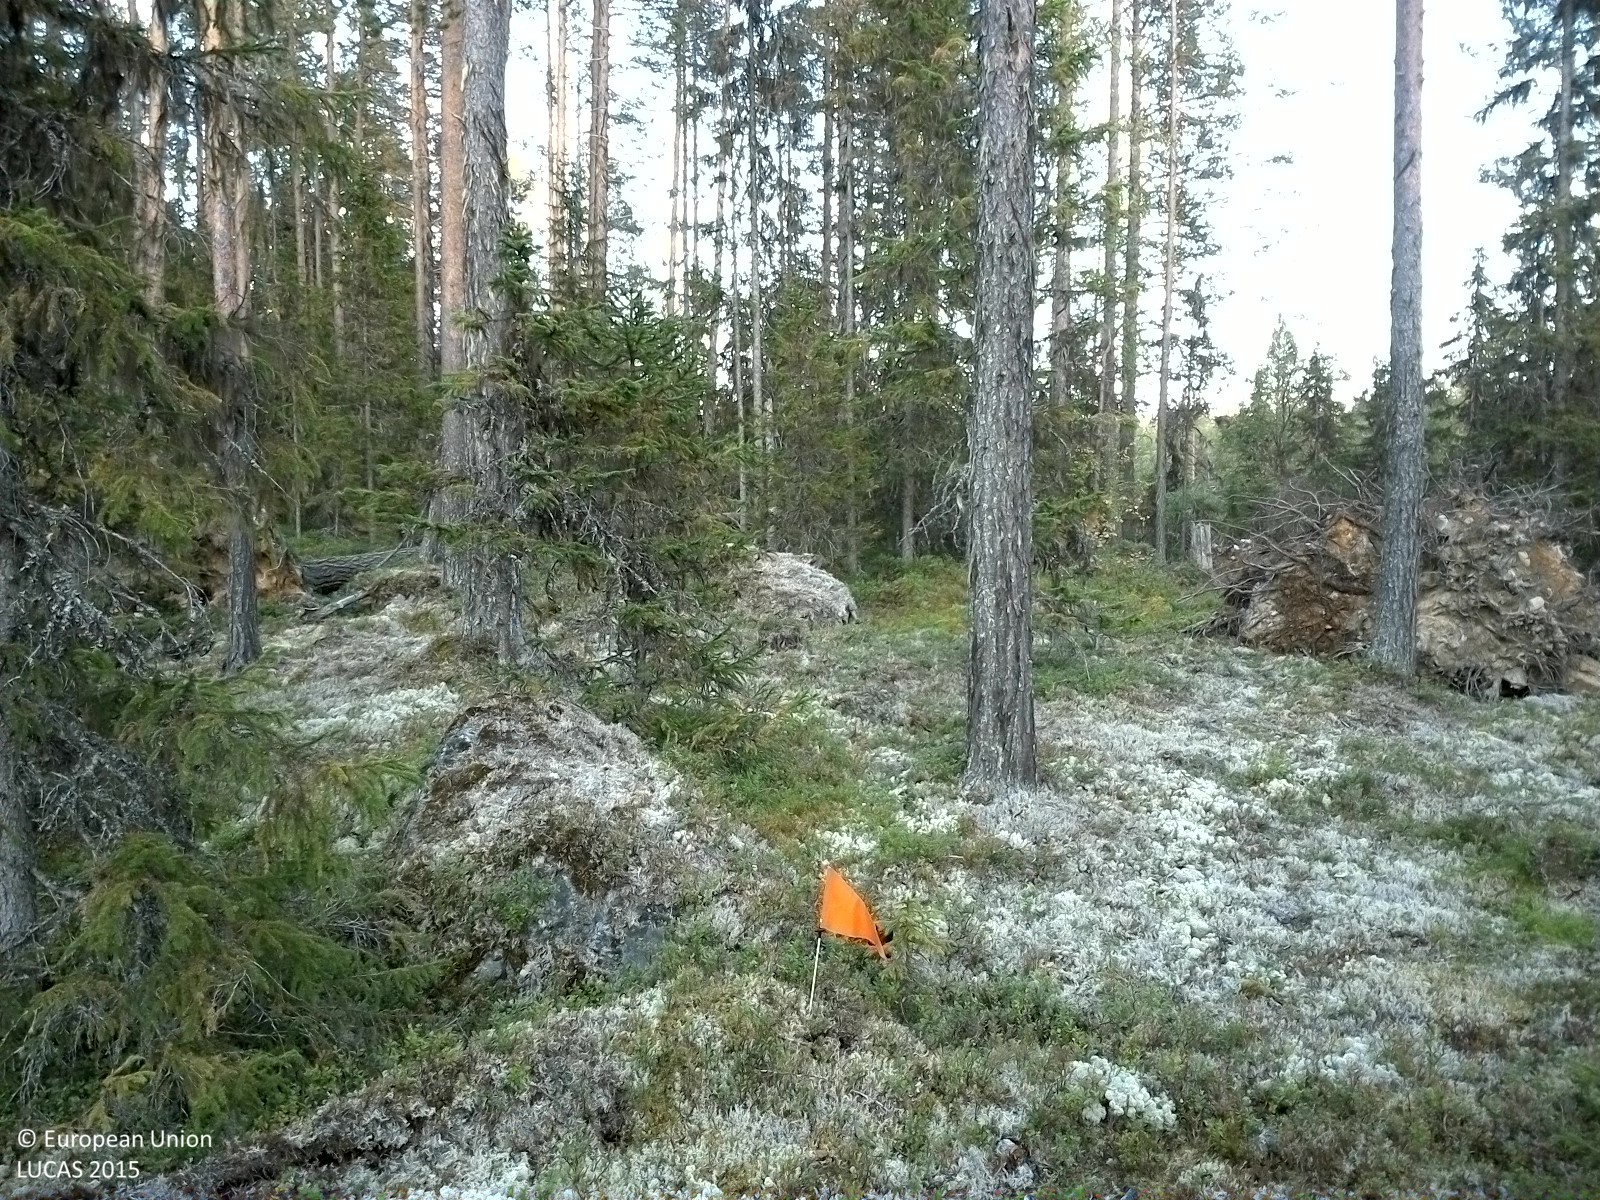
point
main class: Woodland
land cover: Other mixed woodland
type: boreal forest
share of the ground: 50 - 75 %
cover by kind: coniferous forest trees 40 %, lichens and mosses 25 %, shrubs 20 %, broadleaved forest trees 15 %
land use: Forestry
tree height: > 5 m
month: September
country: SE
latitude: 62.6326
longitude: 16.1208
